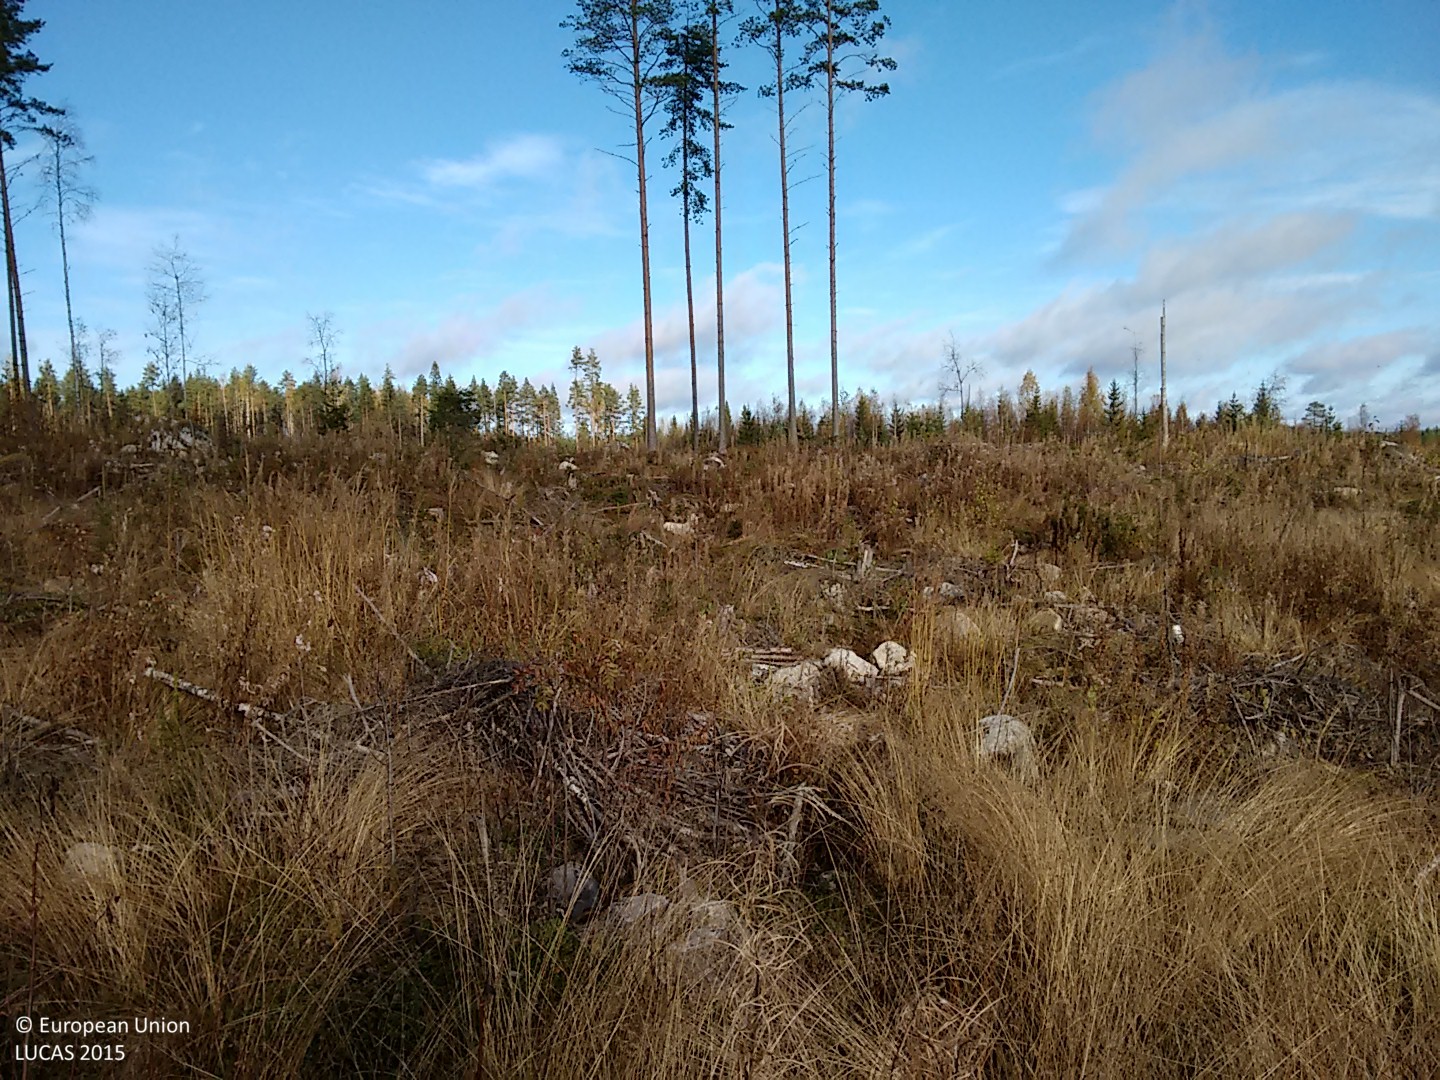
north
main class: Woodland
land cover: Other mixed woodland
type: boreal forest
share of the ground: 25 - 50 %
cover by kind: herbaceous plants 55 %, coniferous forest trees 15 %, broadleaved forest trees 15 %, shrubs 15 %
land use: Forestry
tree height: < 5 m
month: October
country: FI
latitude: 62.6785
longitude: 26.2805
